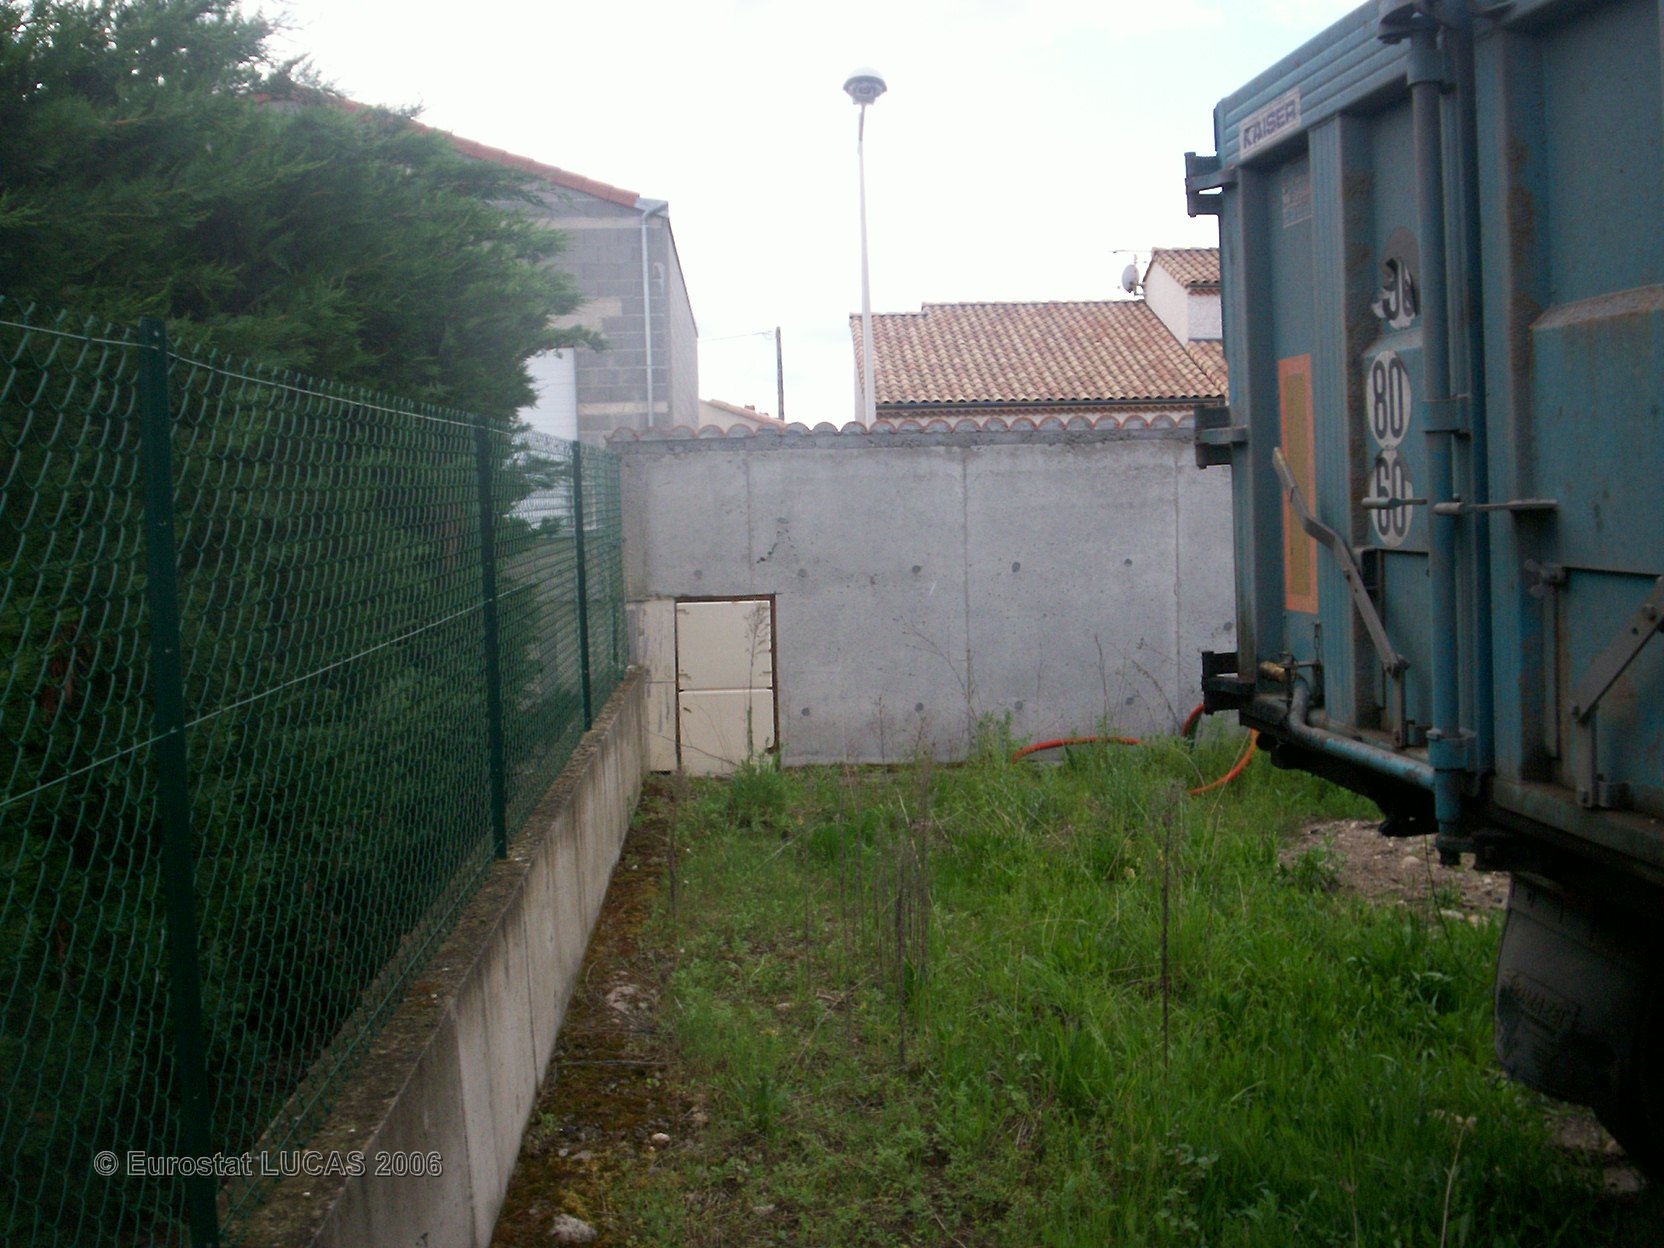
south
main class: Grassland
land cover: Grassland without tree/shrub cover
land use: Residential
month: May
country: FR
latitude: 45.8317
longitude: 3.2673
